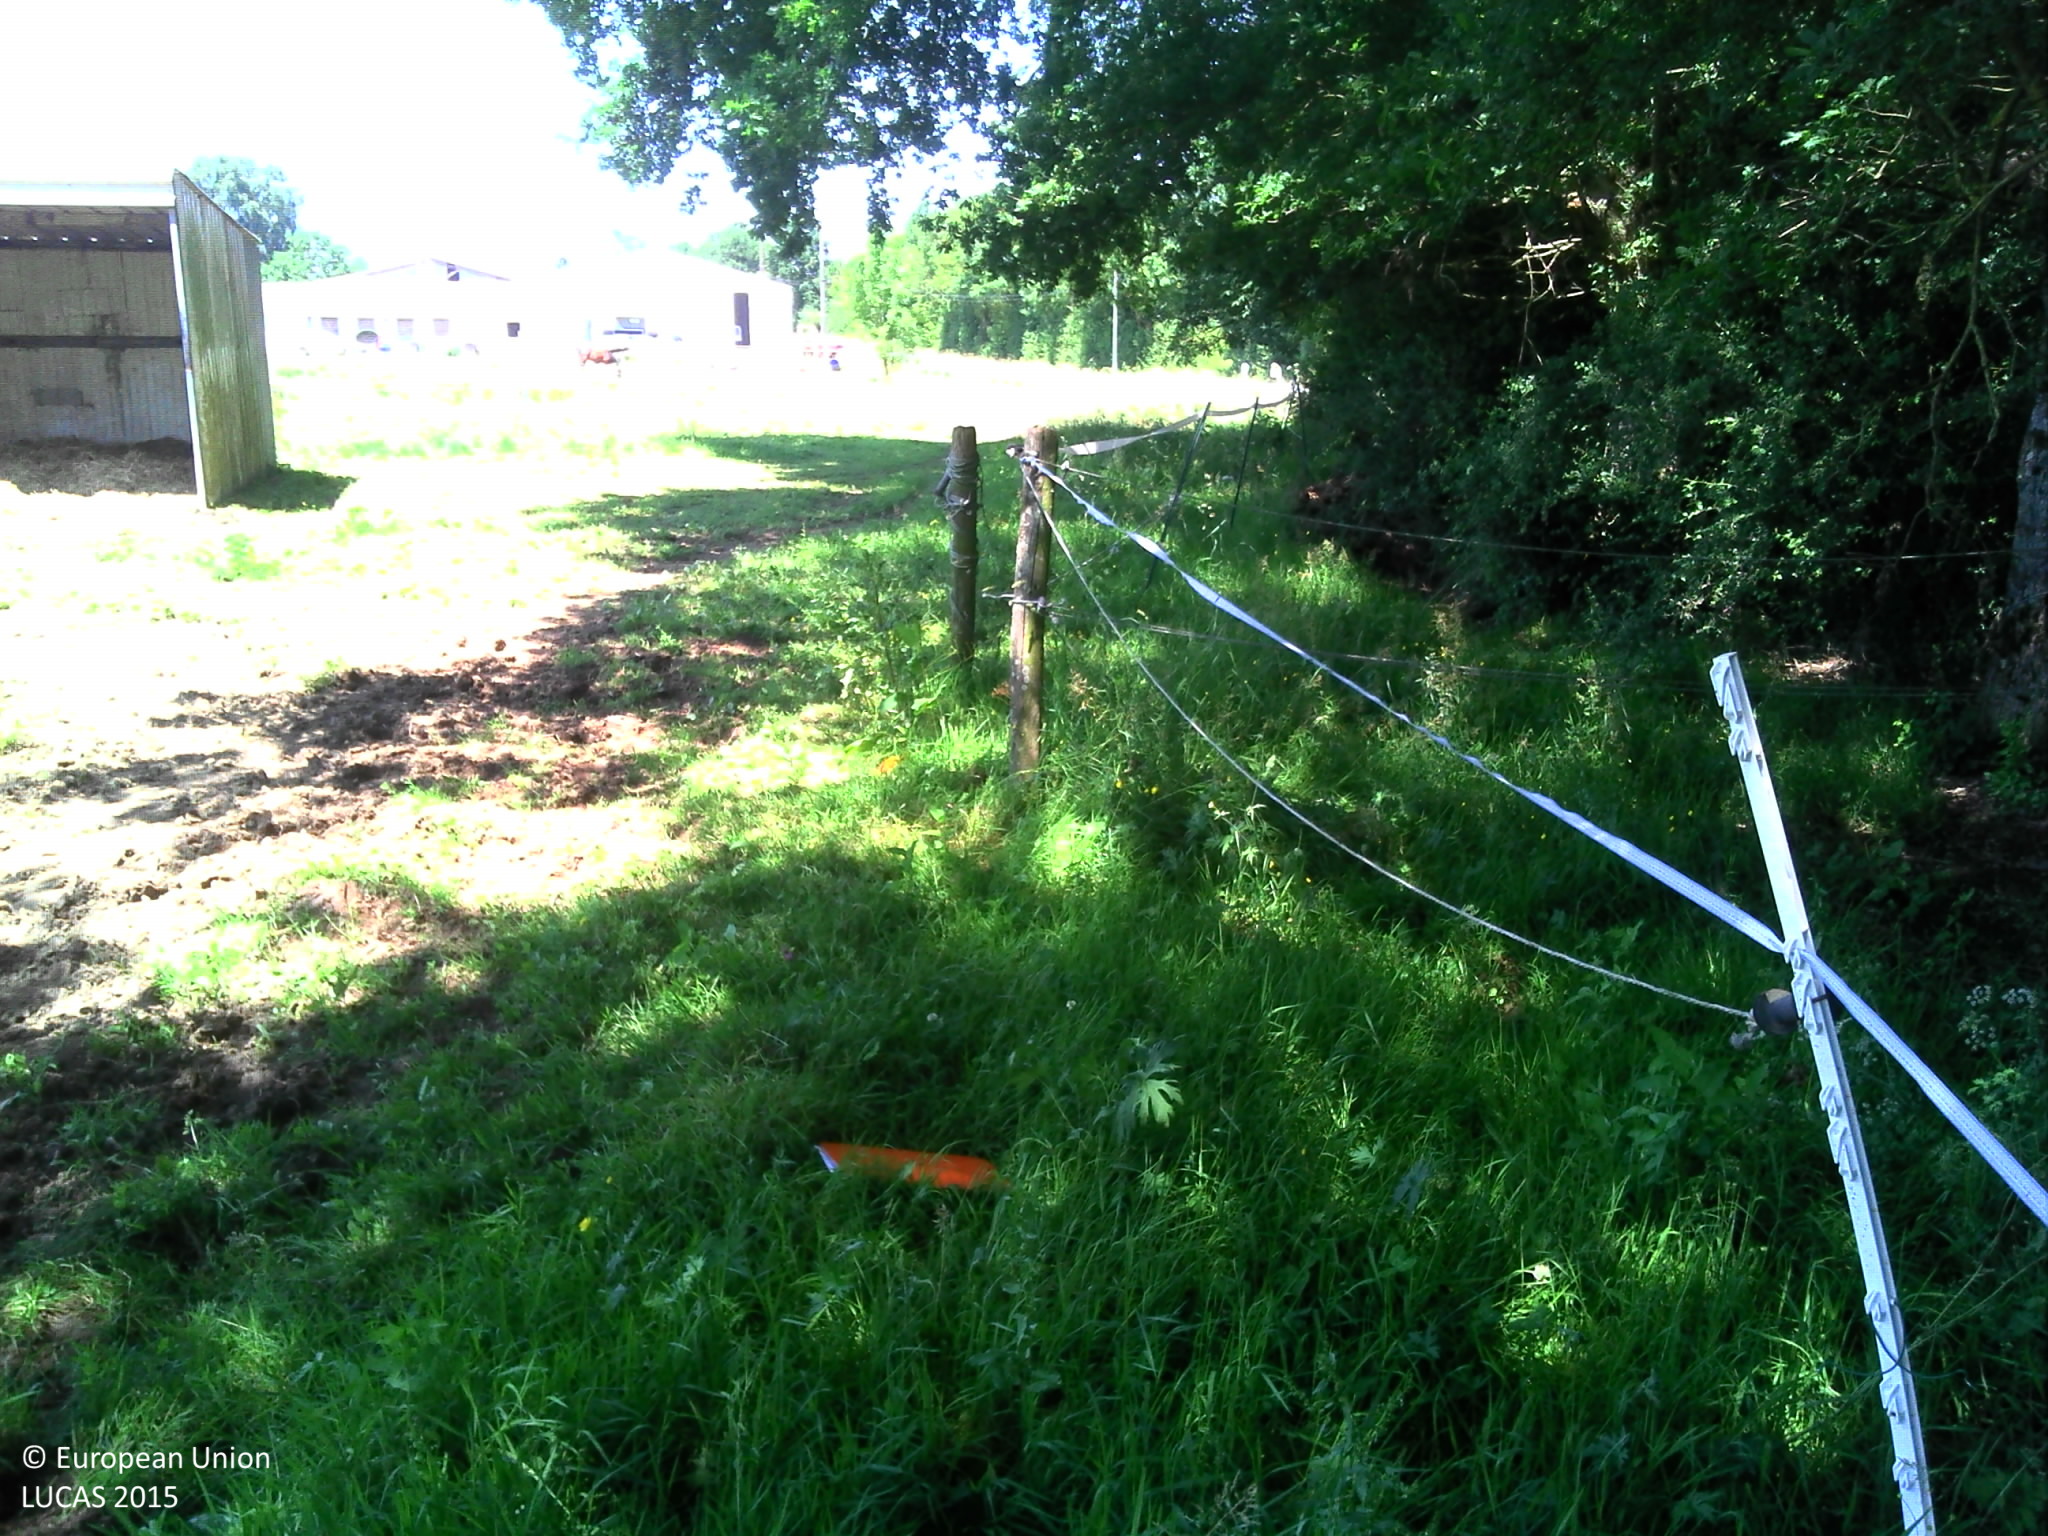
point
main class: Grassland
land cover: Grassland without tree/shrub cover
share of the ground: > 75 %
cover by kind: herbaceous plants 100 %
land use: Sport
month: June
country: FR
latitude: 46.8177
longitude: -1.3486
